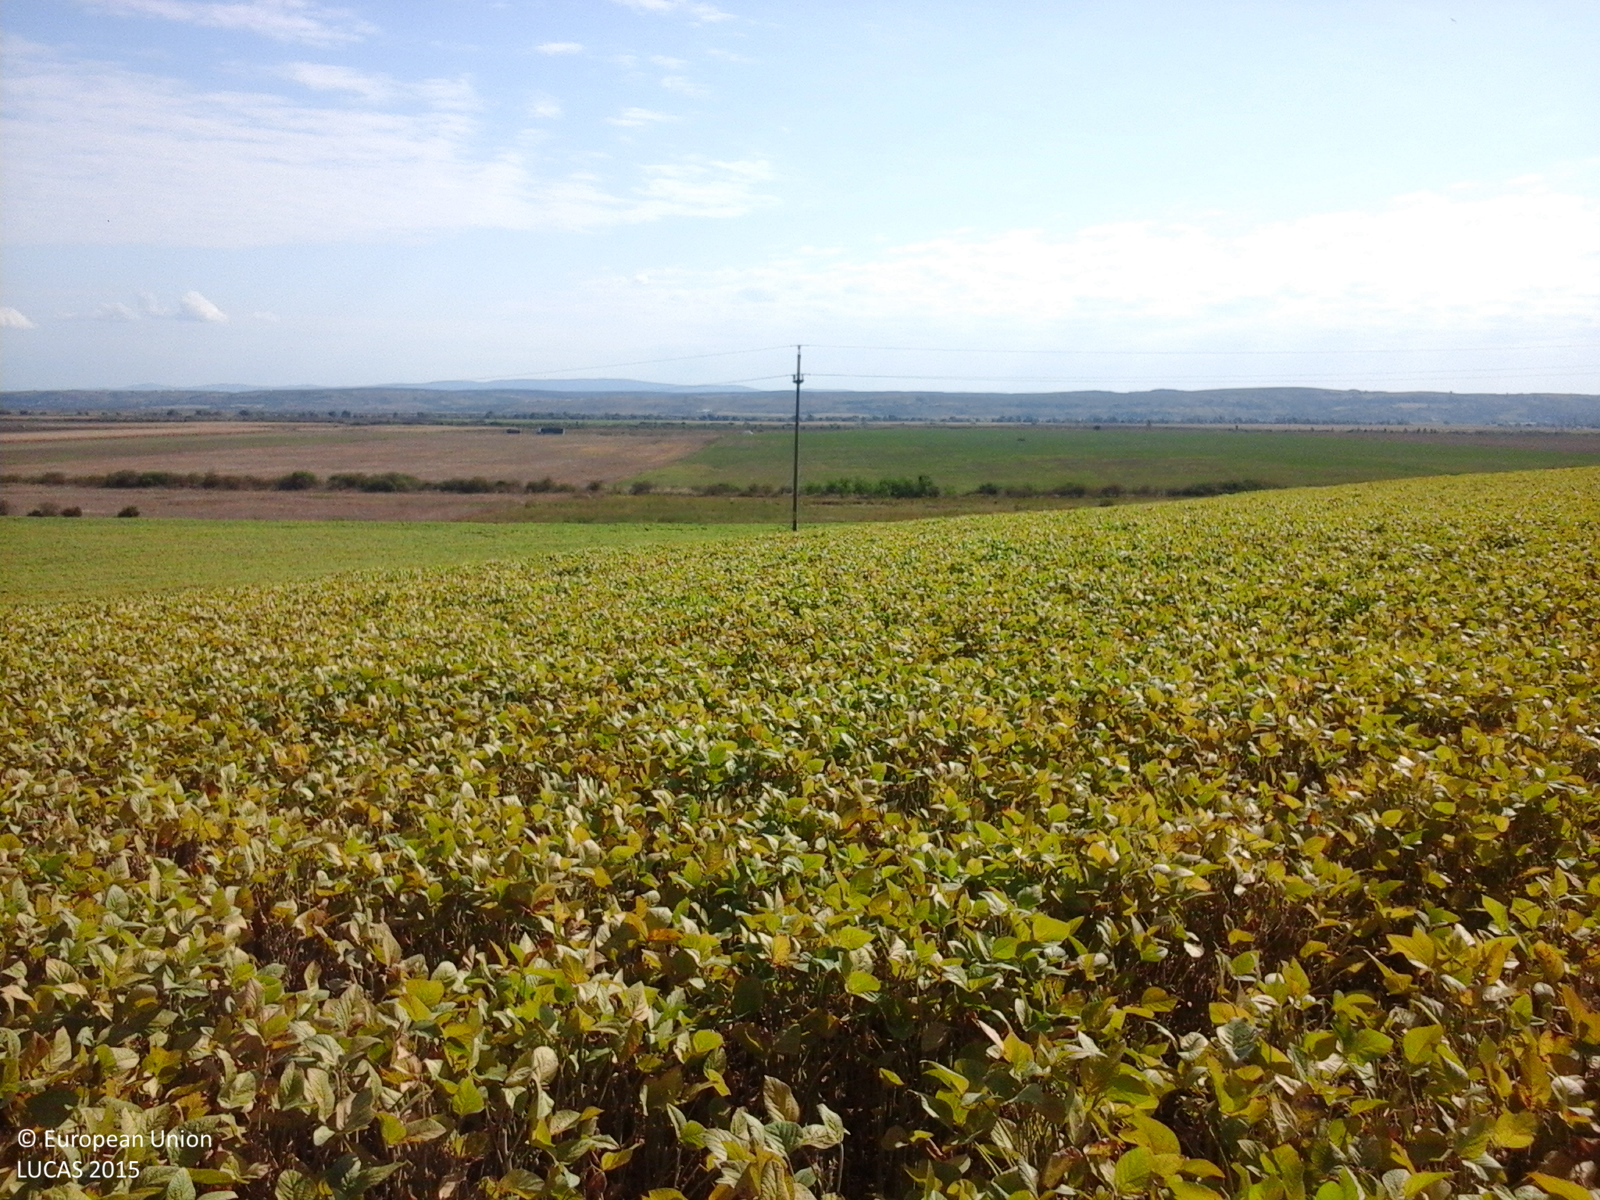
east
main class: Cropland
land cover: Soya
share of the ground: > 75 %
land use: Agriculture (excluding fallow land and kitchen gardens)
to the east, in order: Soya; Electric lines; Soya; Abandoned hedges; Spontaneously vegetated surfaces
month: September
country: RO
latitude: 47.5138
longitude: 22.7690
